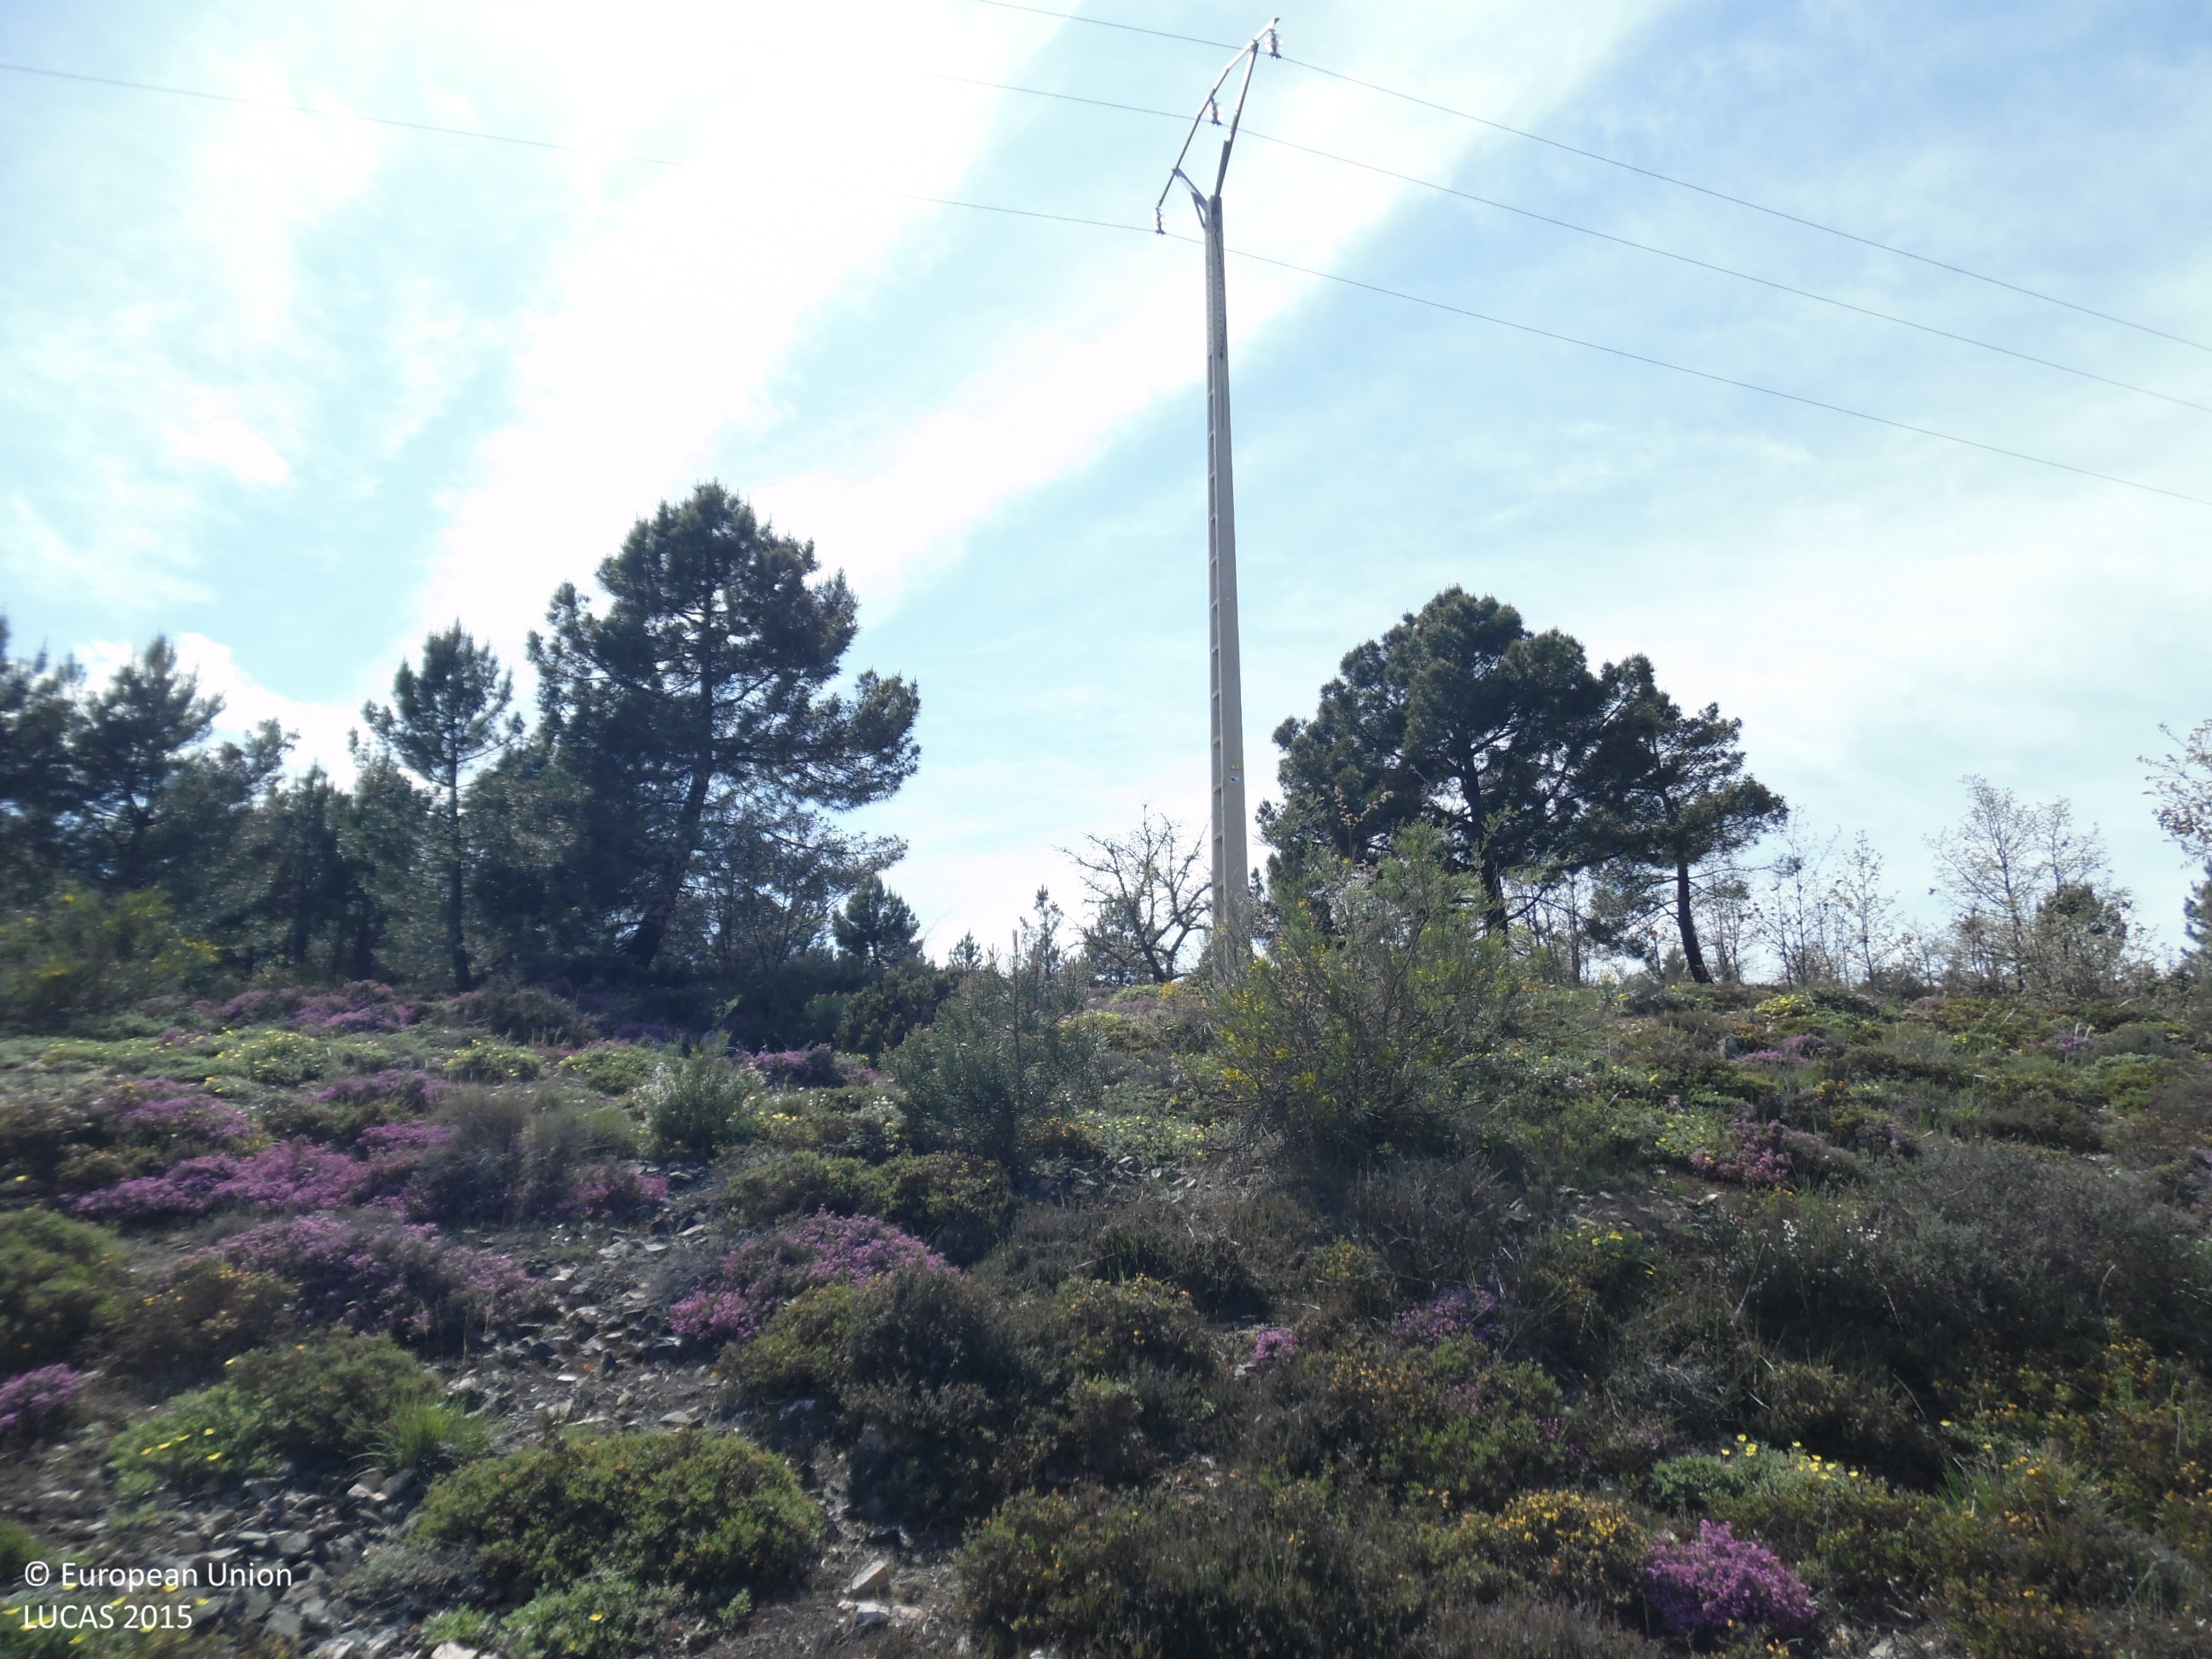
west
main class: Shrubland
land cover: Shrubland with sparse tree cover
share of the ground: > 75 %
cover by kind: shrubs 95 %, broadleaved forest trees 5 %
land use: Forestry
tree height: < 5 m
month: May
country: ES
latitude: 42.5724
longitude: -6.0792
